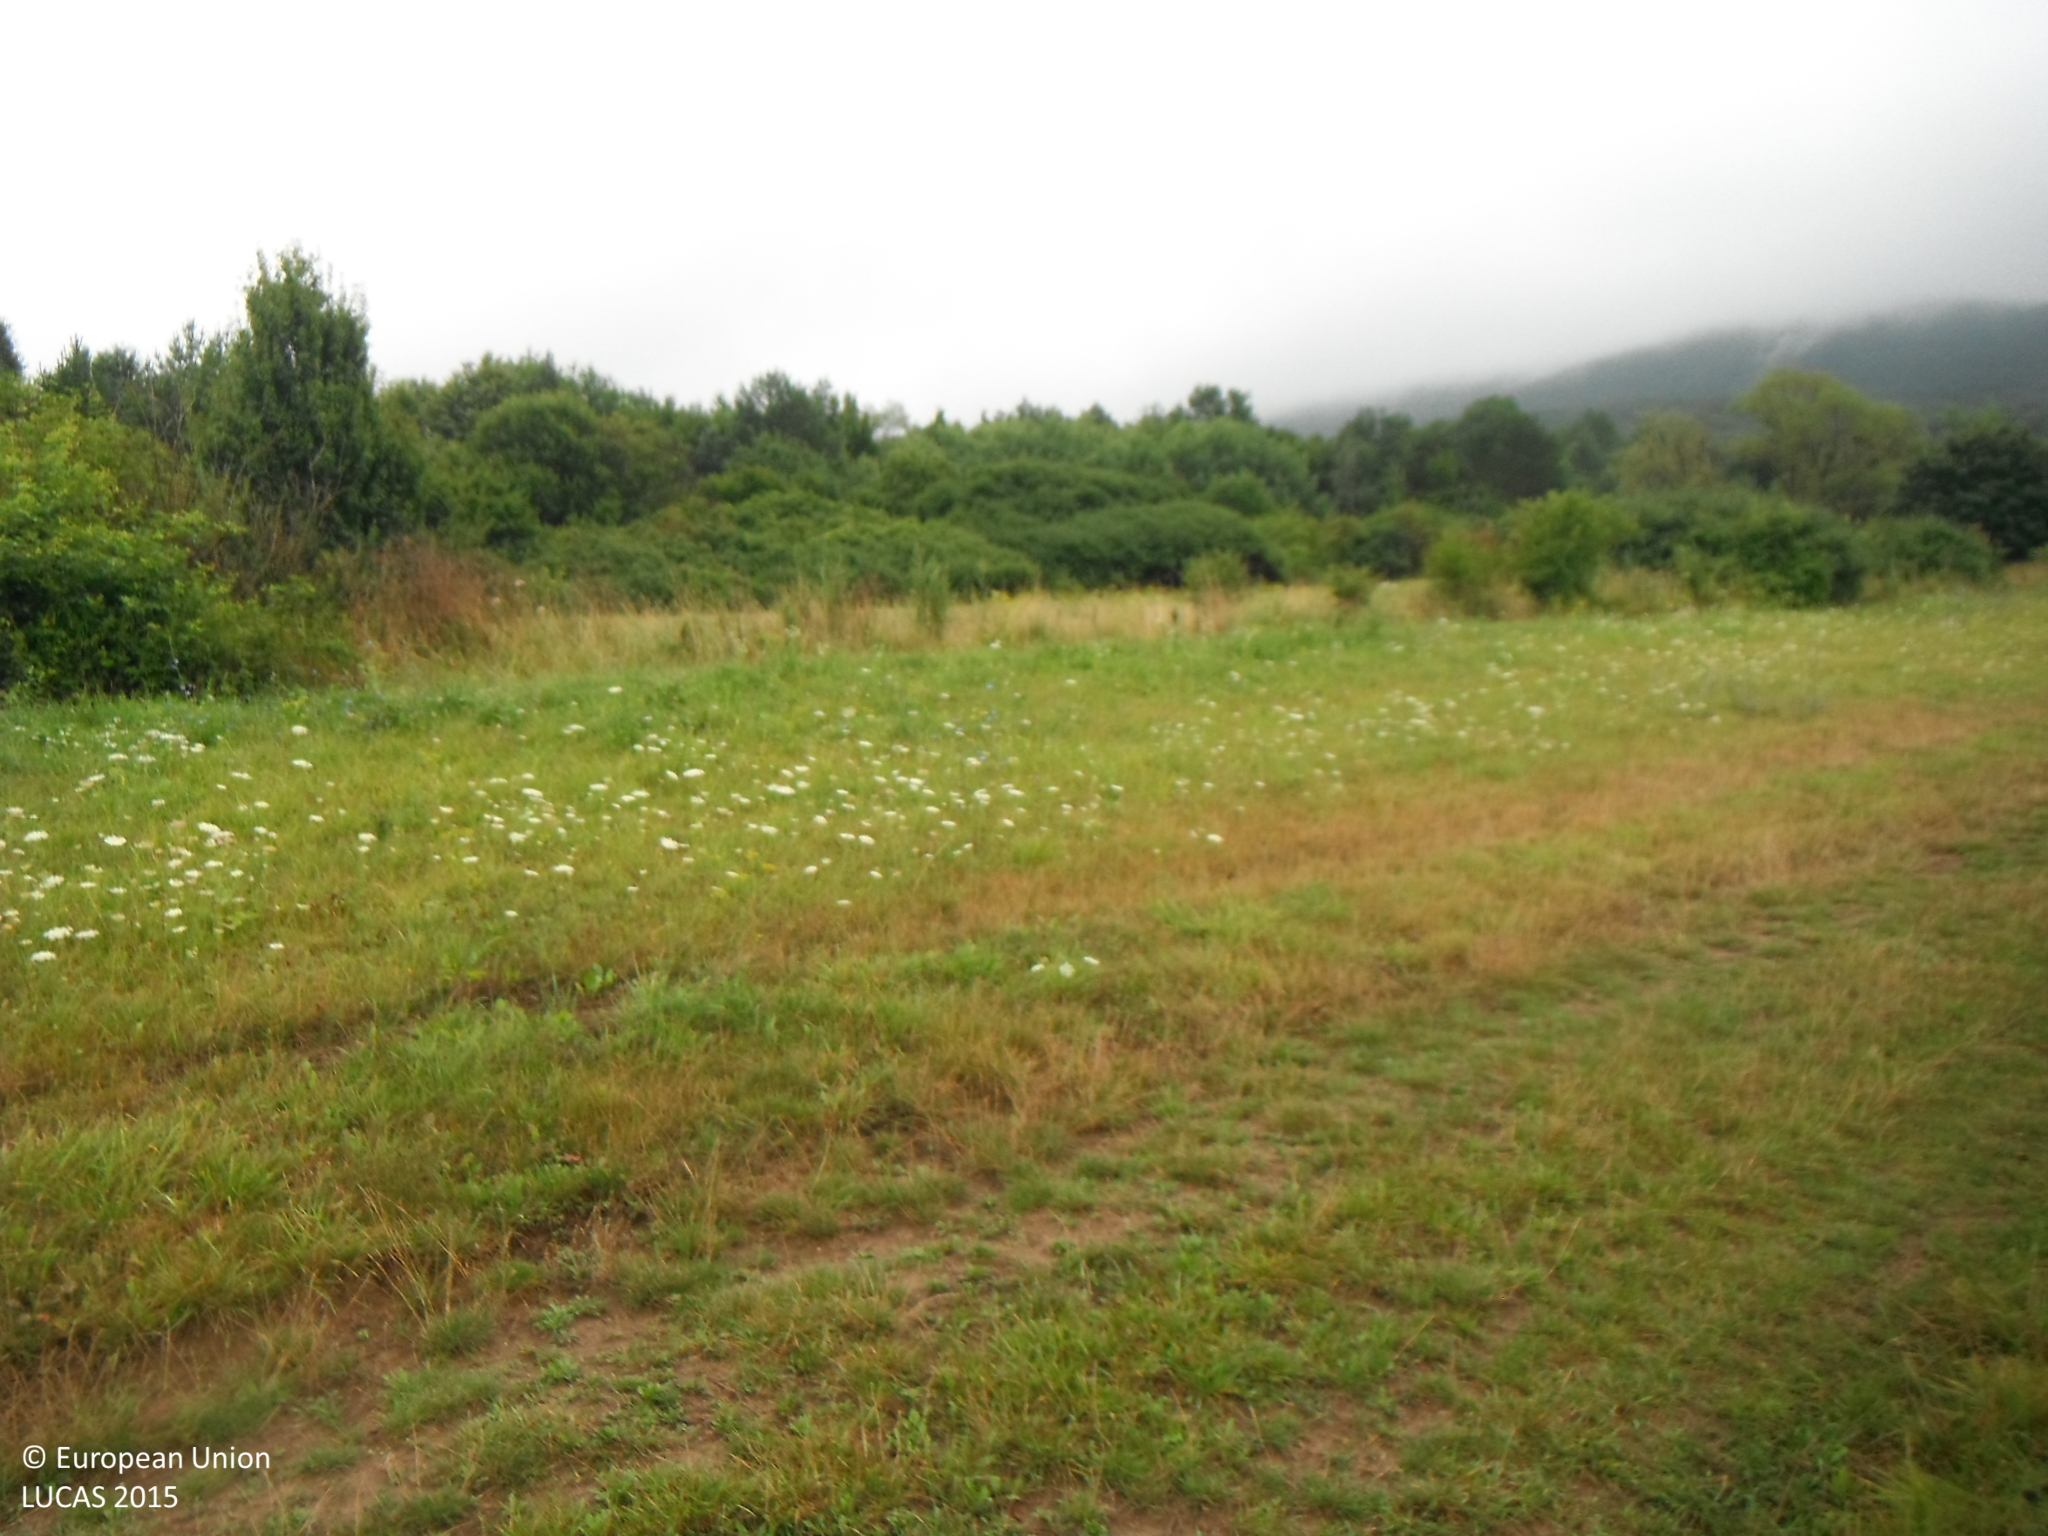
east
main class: Grassland
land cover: Grassland without tree/shrub cover
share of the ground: > 75 %
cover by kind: herbaceous plants 100 %
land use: Agriculture (excluding fallow land and kitchen gardens)
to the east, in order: Grassland without tree/shrub cover; Tracks; Grassland without tree/shrub cover; Shrubland without tree cover; Grassland without tree/shrub cover; Shrubland with sparse tree cover; Broadleaved woodland; Ditches and canals; Broadleaved woodland; Fences; Broadleaved woodland; Grassland with sparse tree/shrub cover; Shrubland without tree cover; Fences; Shrubland without tree cover; Grassland with sparse tree/shrub cover
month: July
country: SK
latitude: 48.8971
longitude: 21.9630
